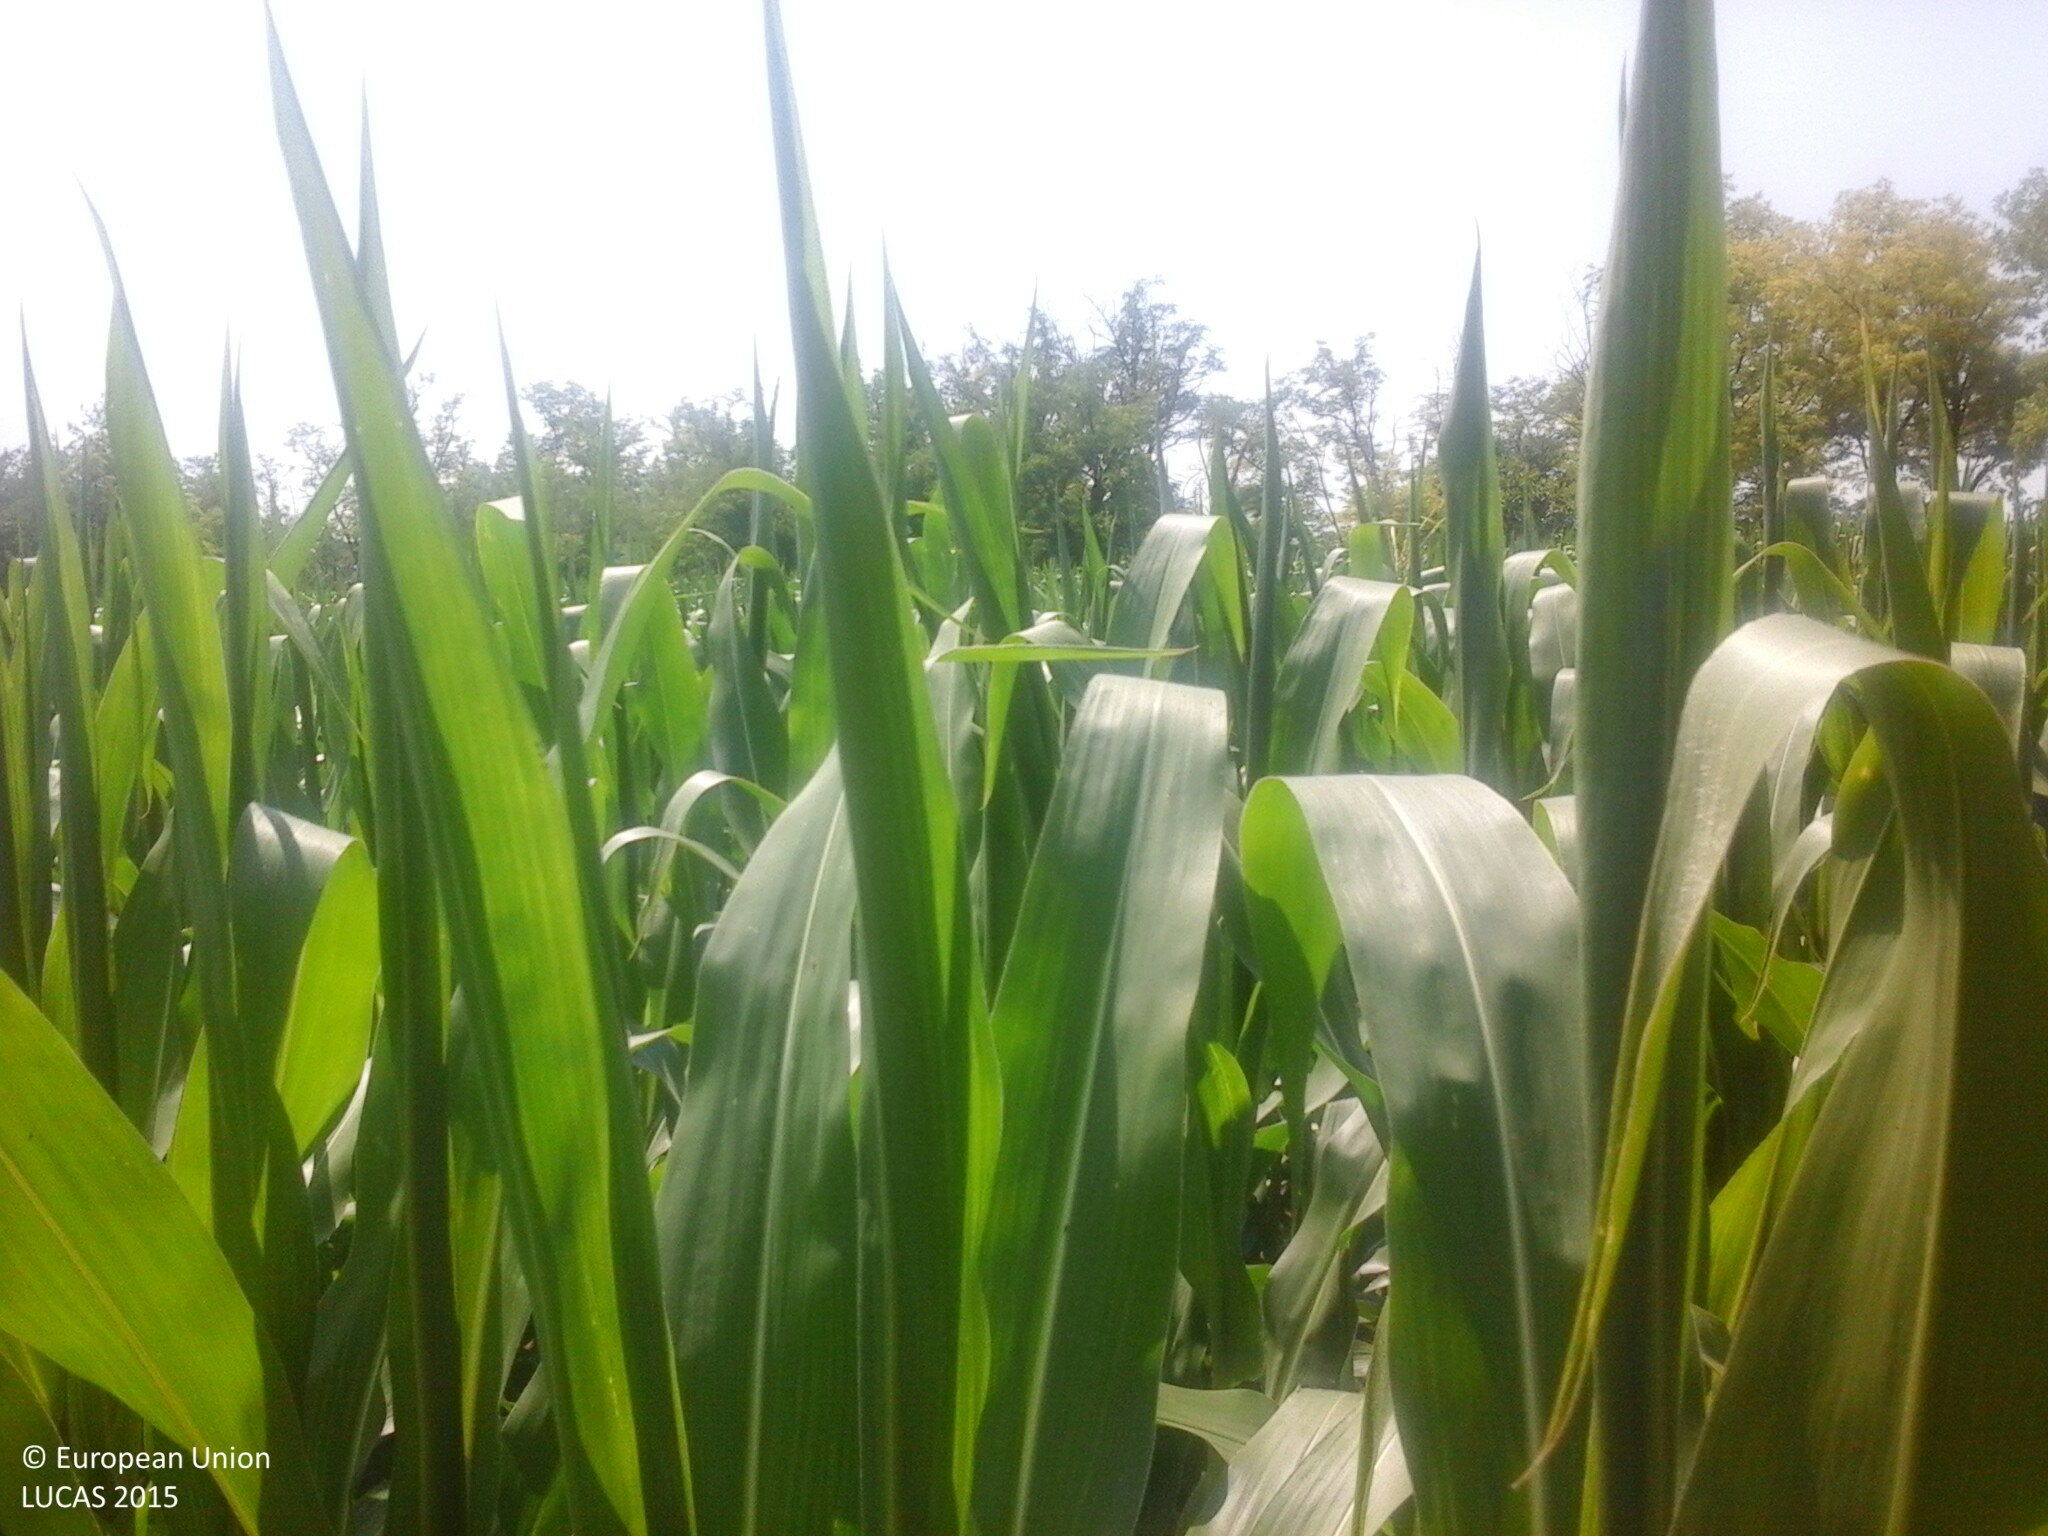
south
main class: Cropland
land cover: Maize
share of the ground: > 75 %
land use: Agriculture (excluding fallow land and kitchen gardens)
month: July
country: HU
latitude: 47.4729
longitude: 18.5724
